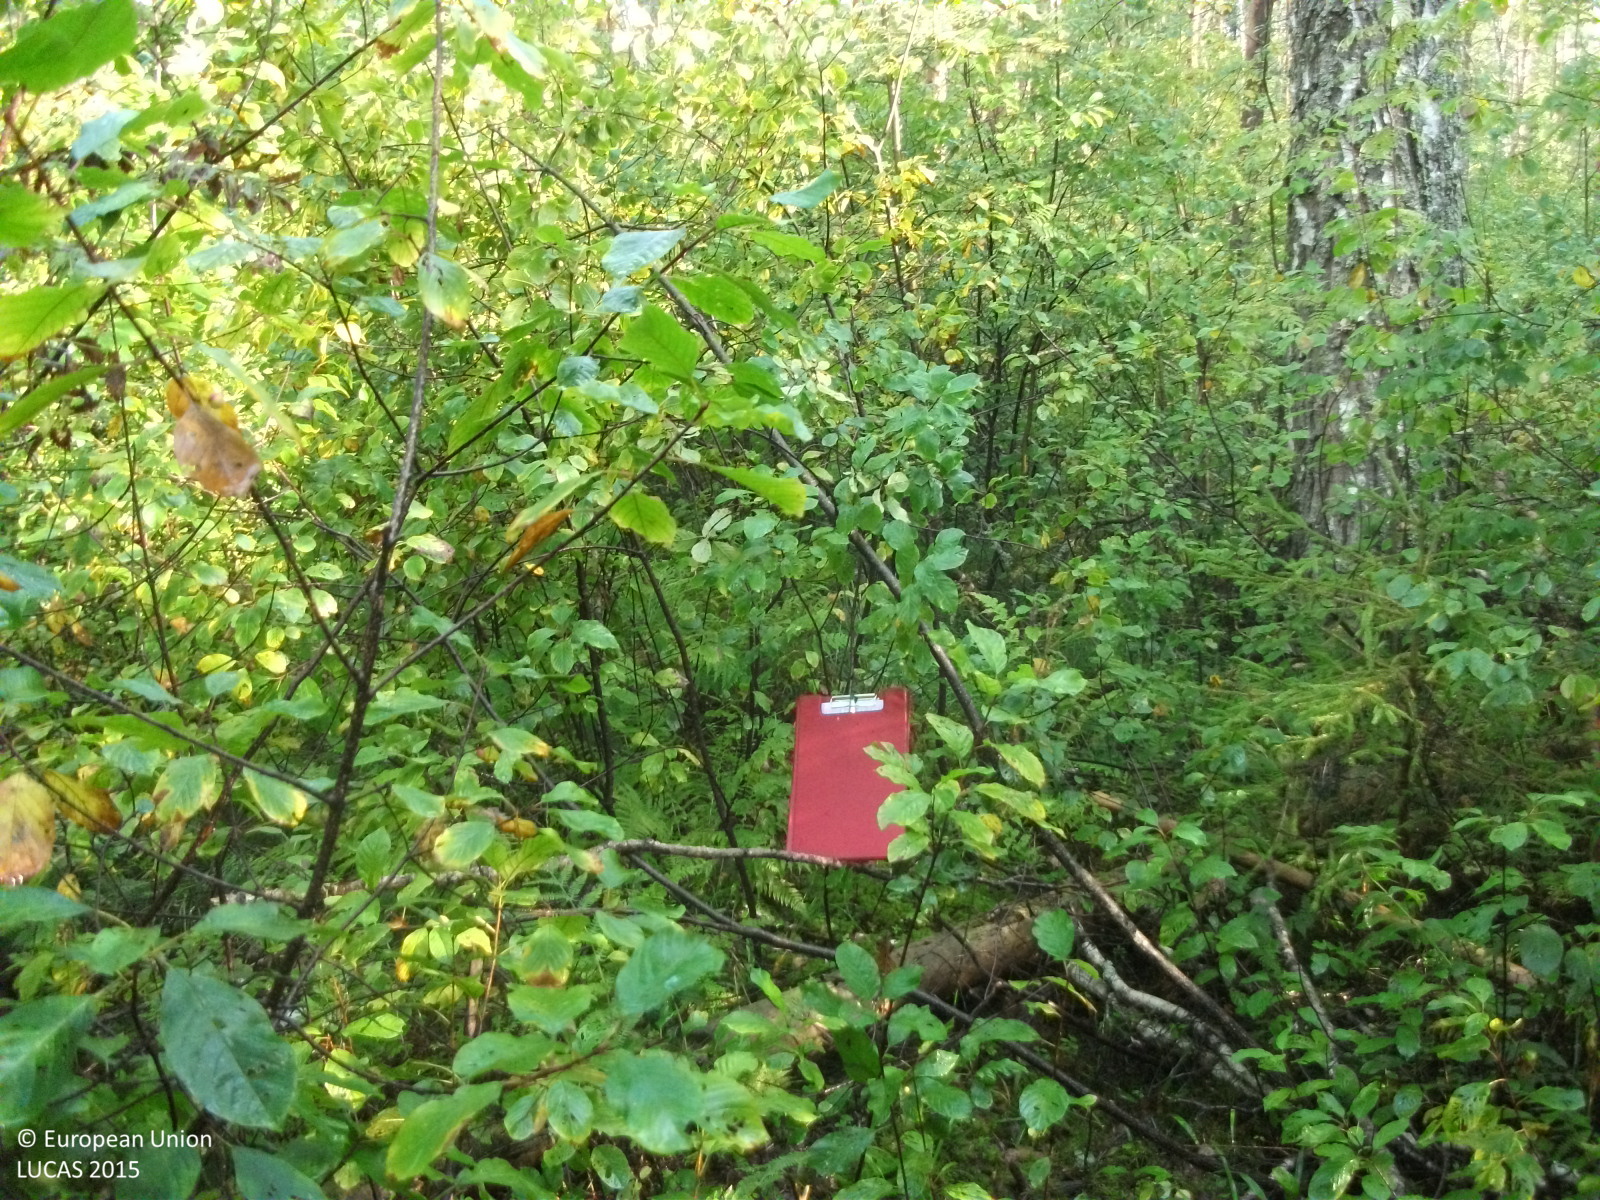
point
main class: Woodland
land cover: Broadleaved woodland
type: non-riverine alder, birch or aspen forest
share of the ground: 50 - 75 %
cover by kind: broadleaved forest trees 55 %, shrubs 30 %, coniferous forest trees 15 %
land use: Forestry
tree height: > 5 m
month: September
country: LV
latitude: 57.5495
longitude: 24.7168
